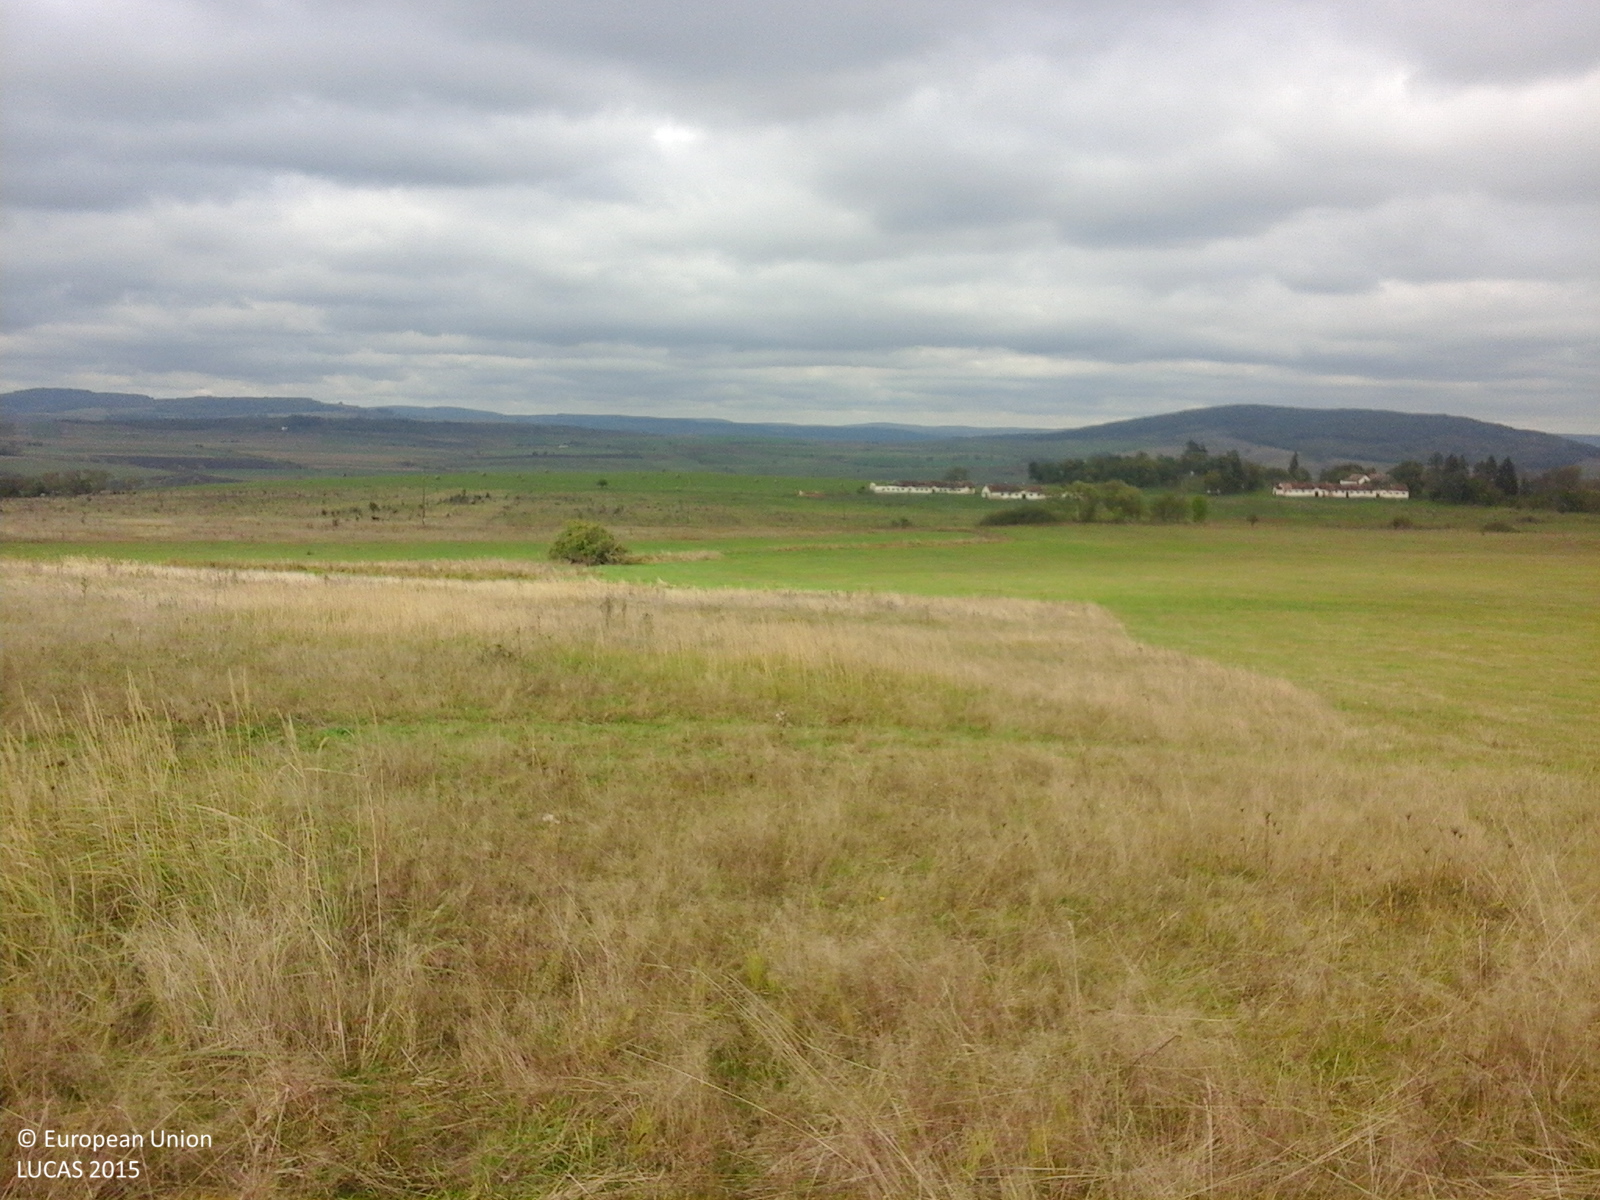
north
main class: Grassland
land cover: Grassland without tree/shrub cover
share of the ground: > 75 %
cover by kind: herbaceous plants 100 %
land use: Agriculture (excluding fallow land and kitchen gardens)
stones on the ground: < 10 %
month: October
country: RO
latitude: 45.9397
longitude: 24.6481
